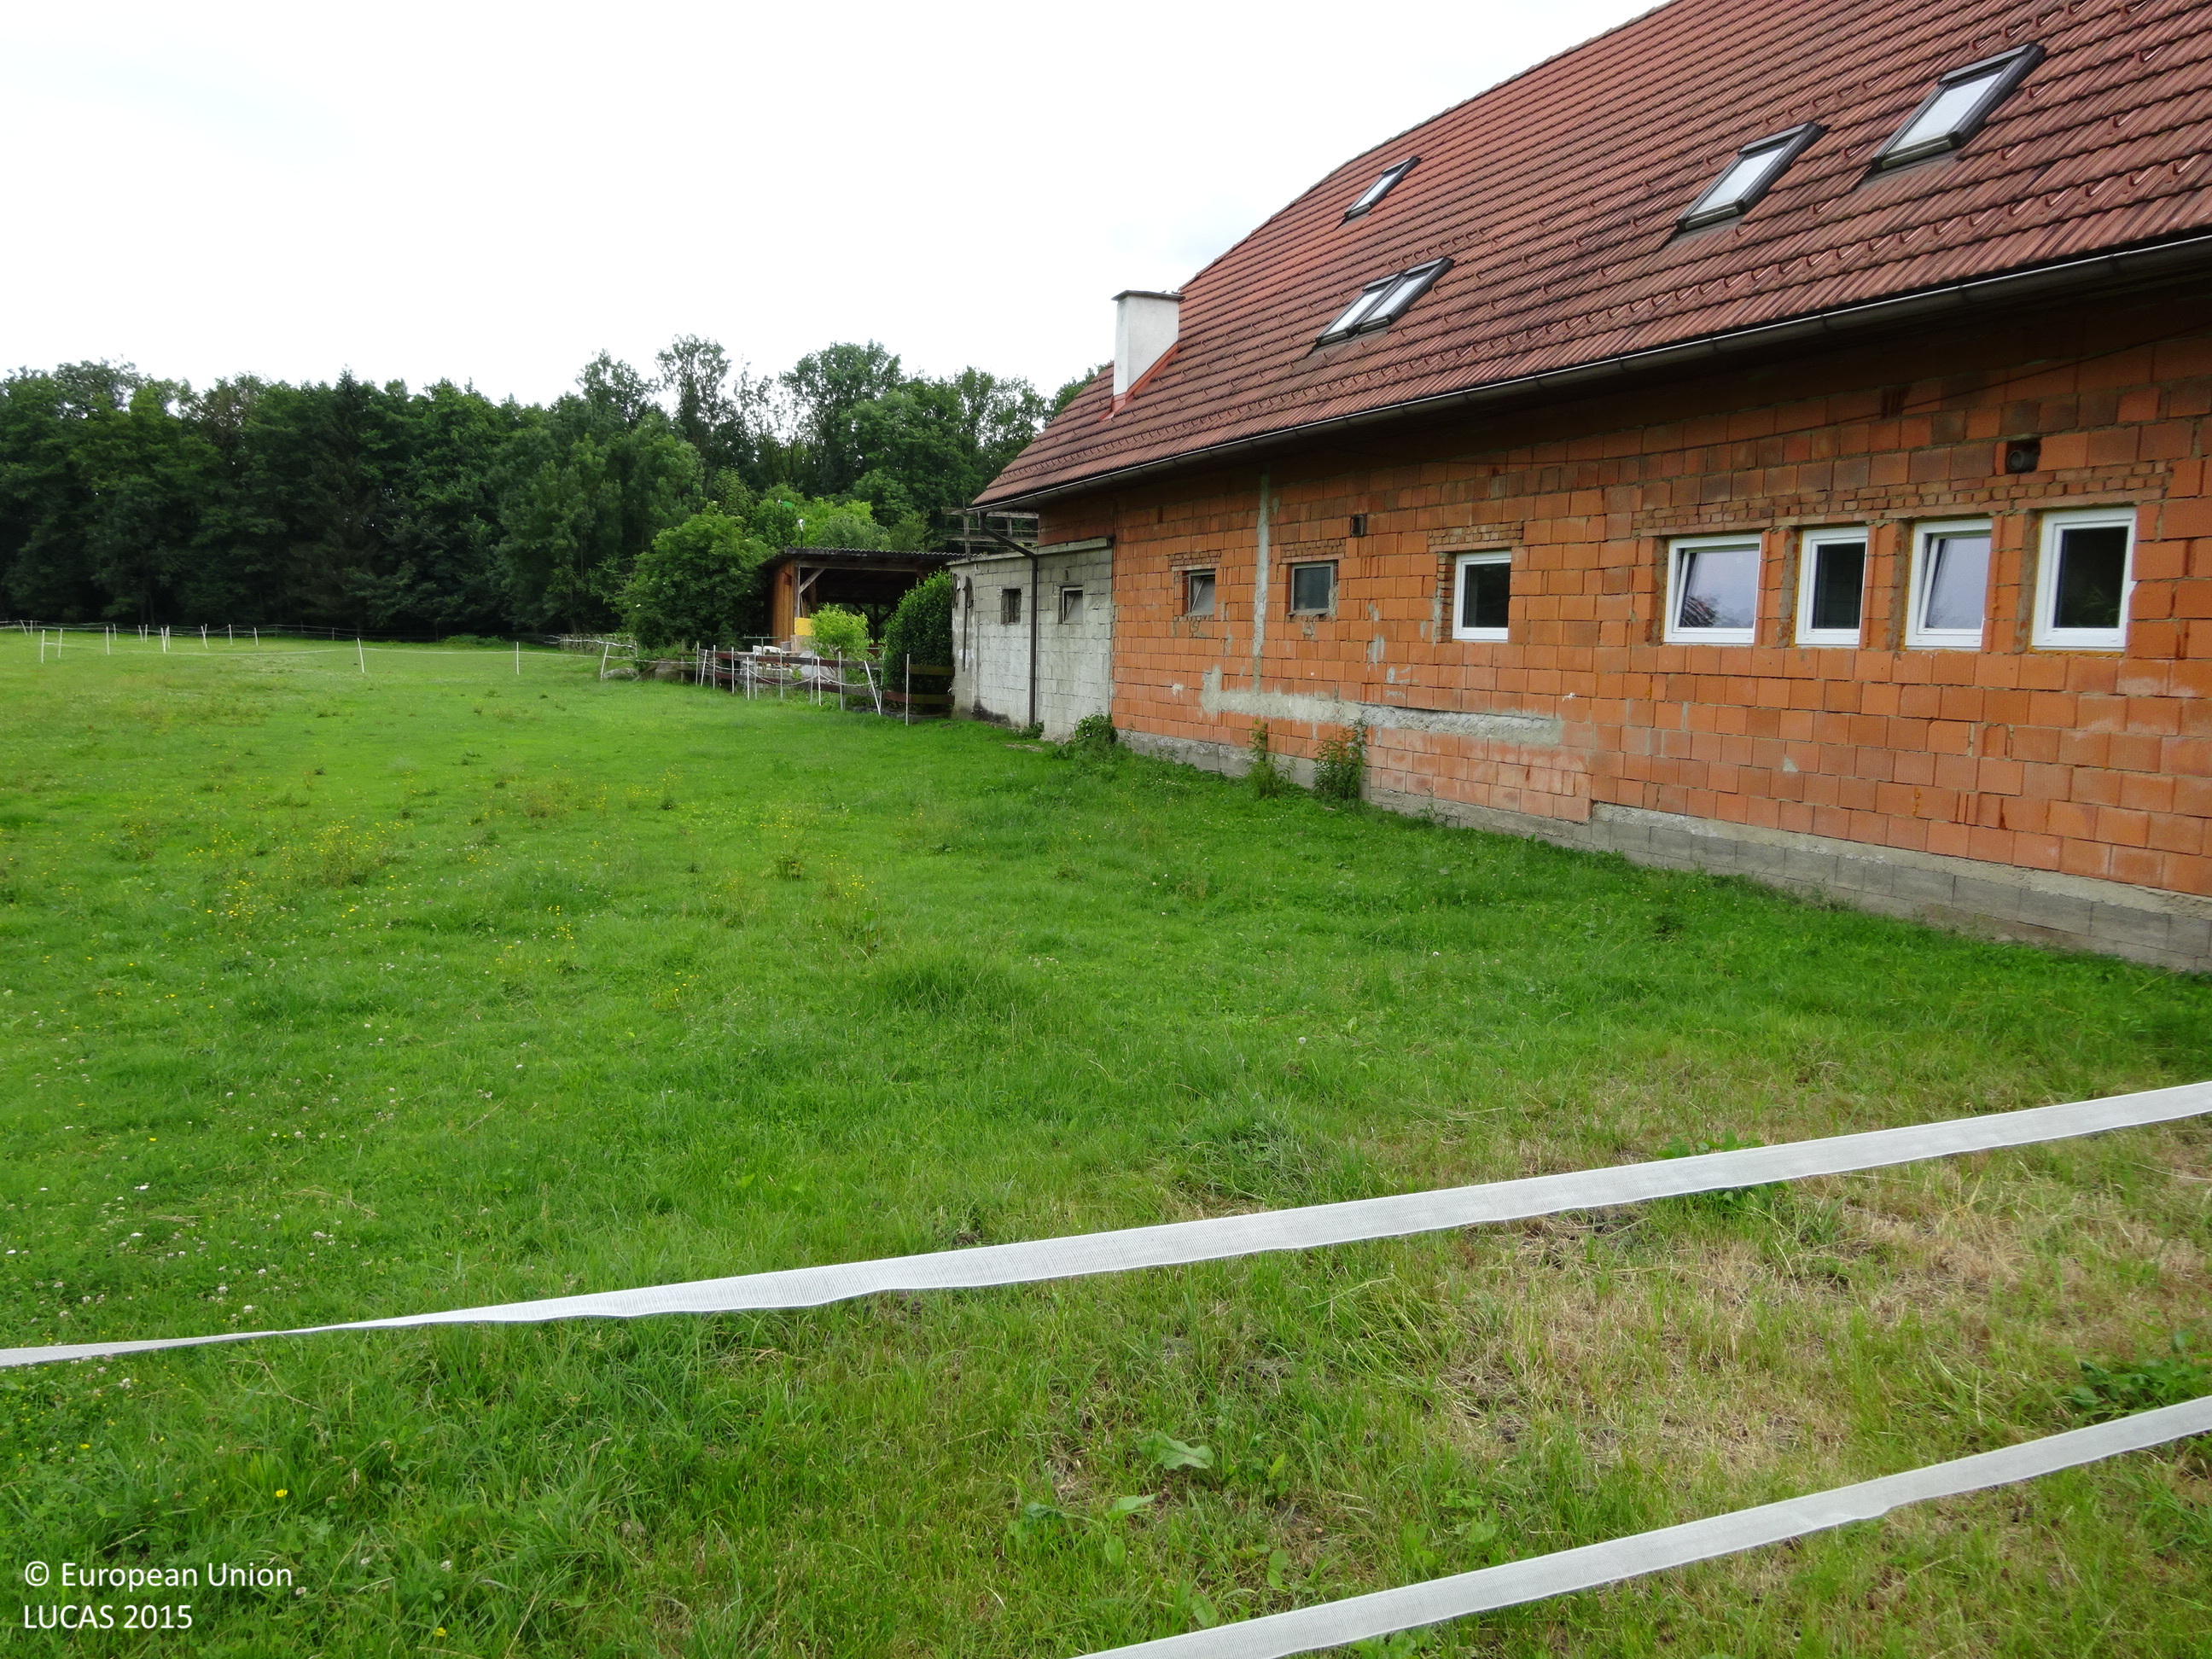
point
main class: Grassland
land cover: Grassland without tree/shrub cover
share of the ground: > 75 %
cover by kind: herbaceous plants 100 %
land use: Agriculture (excluding fallow land and kitchen gardens)
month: June
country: AT
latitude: 46.7273
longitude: 15.6128
